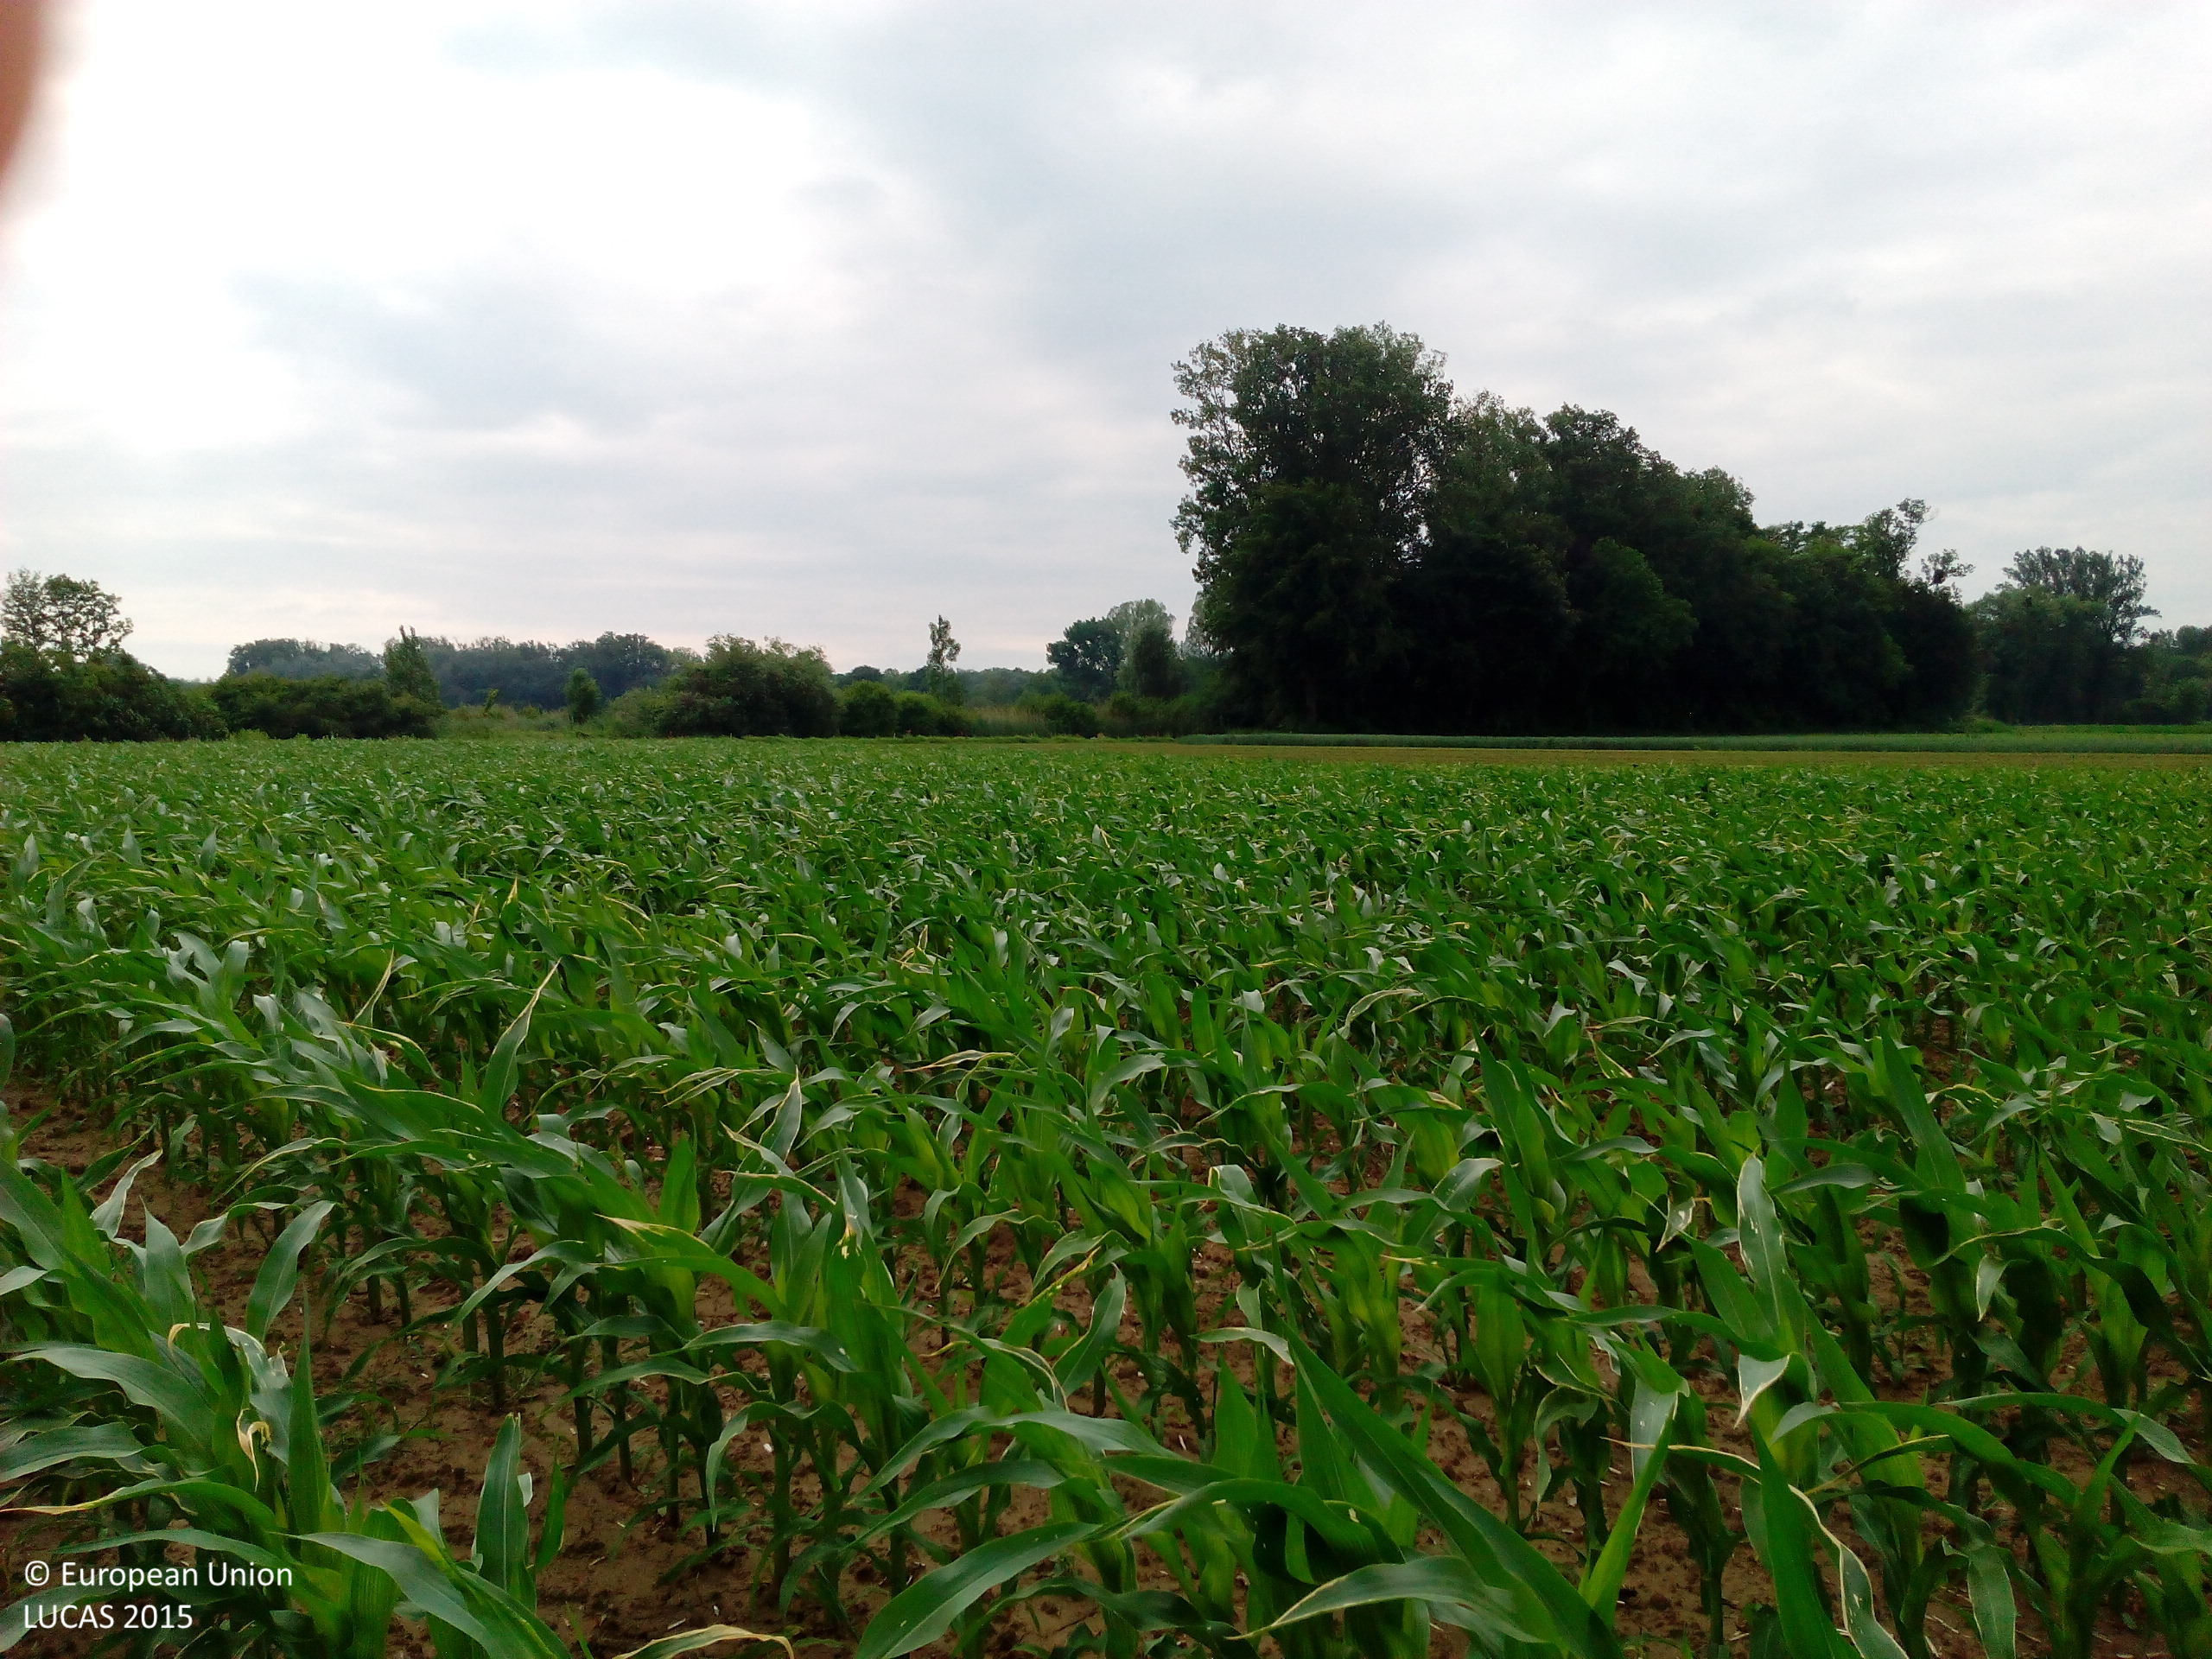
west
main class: Cropland
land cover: Maize
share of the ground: > 75 %
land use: Agriculture (excluding fallow land and kitchen gardens)
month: June
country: DE
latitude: 48.1619
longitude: 7.6214
